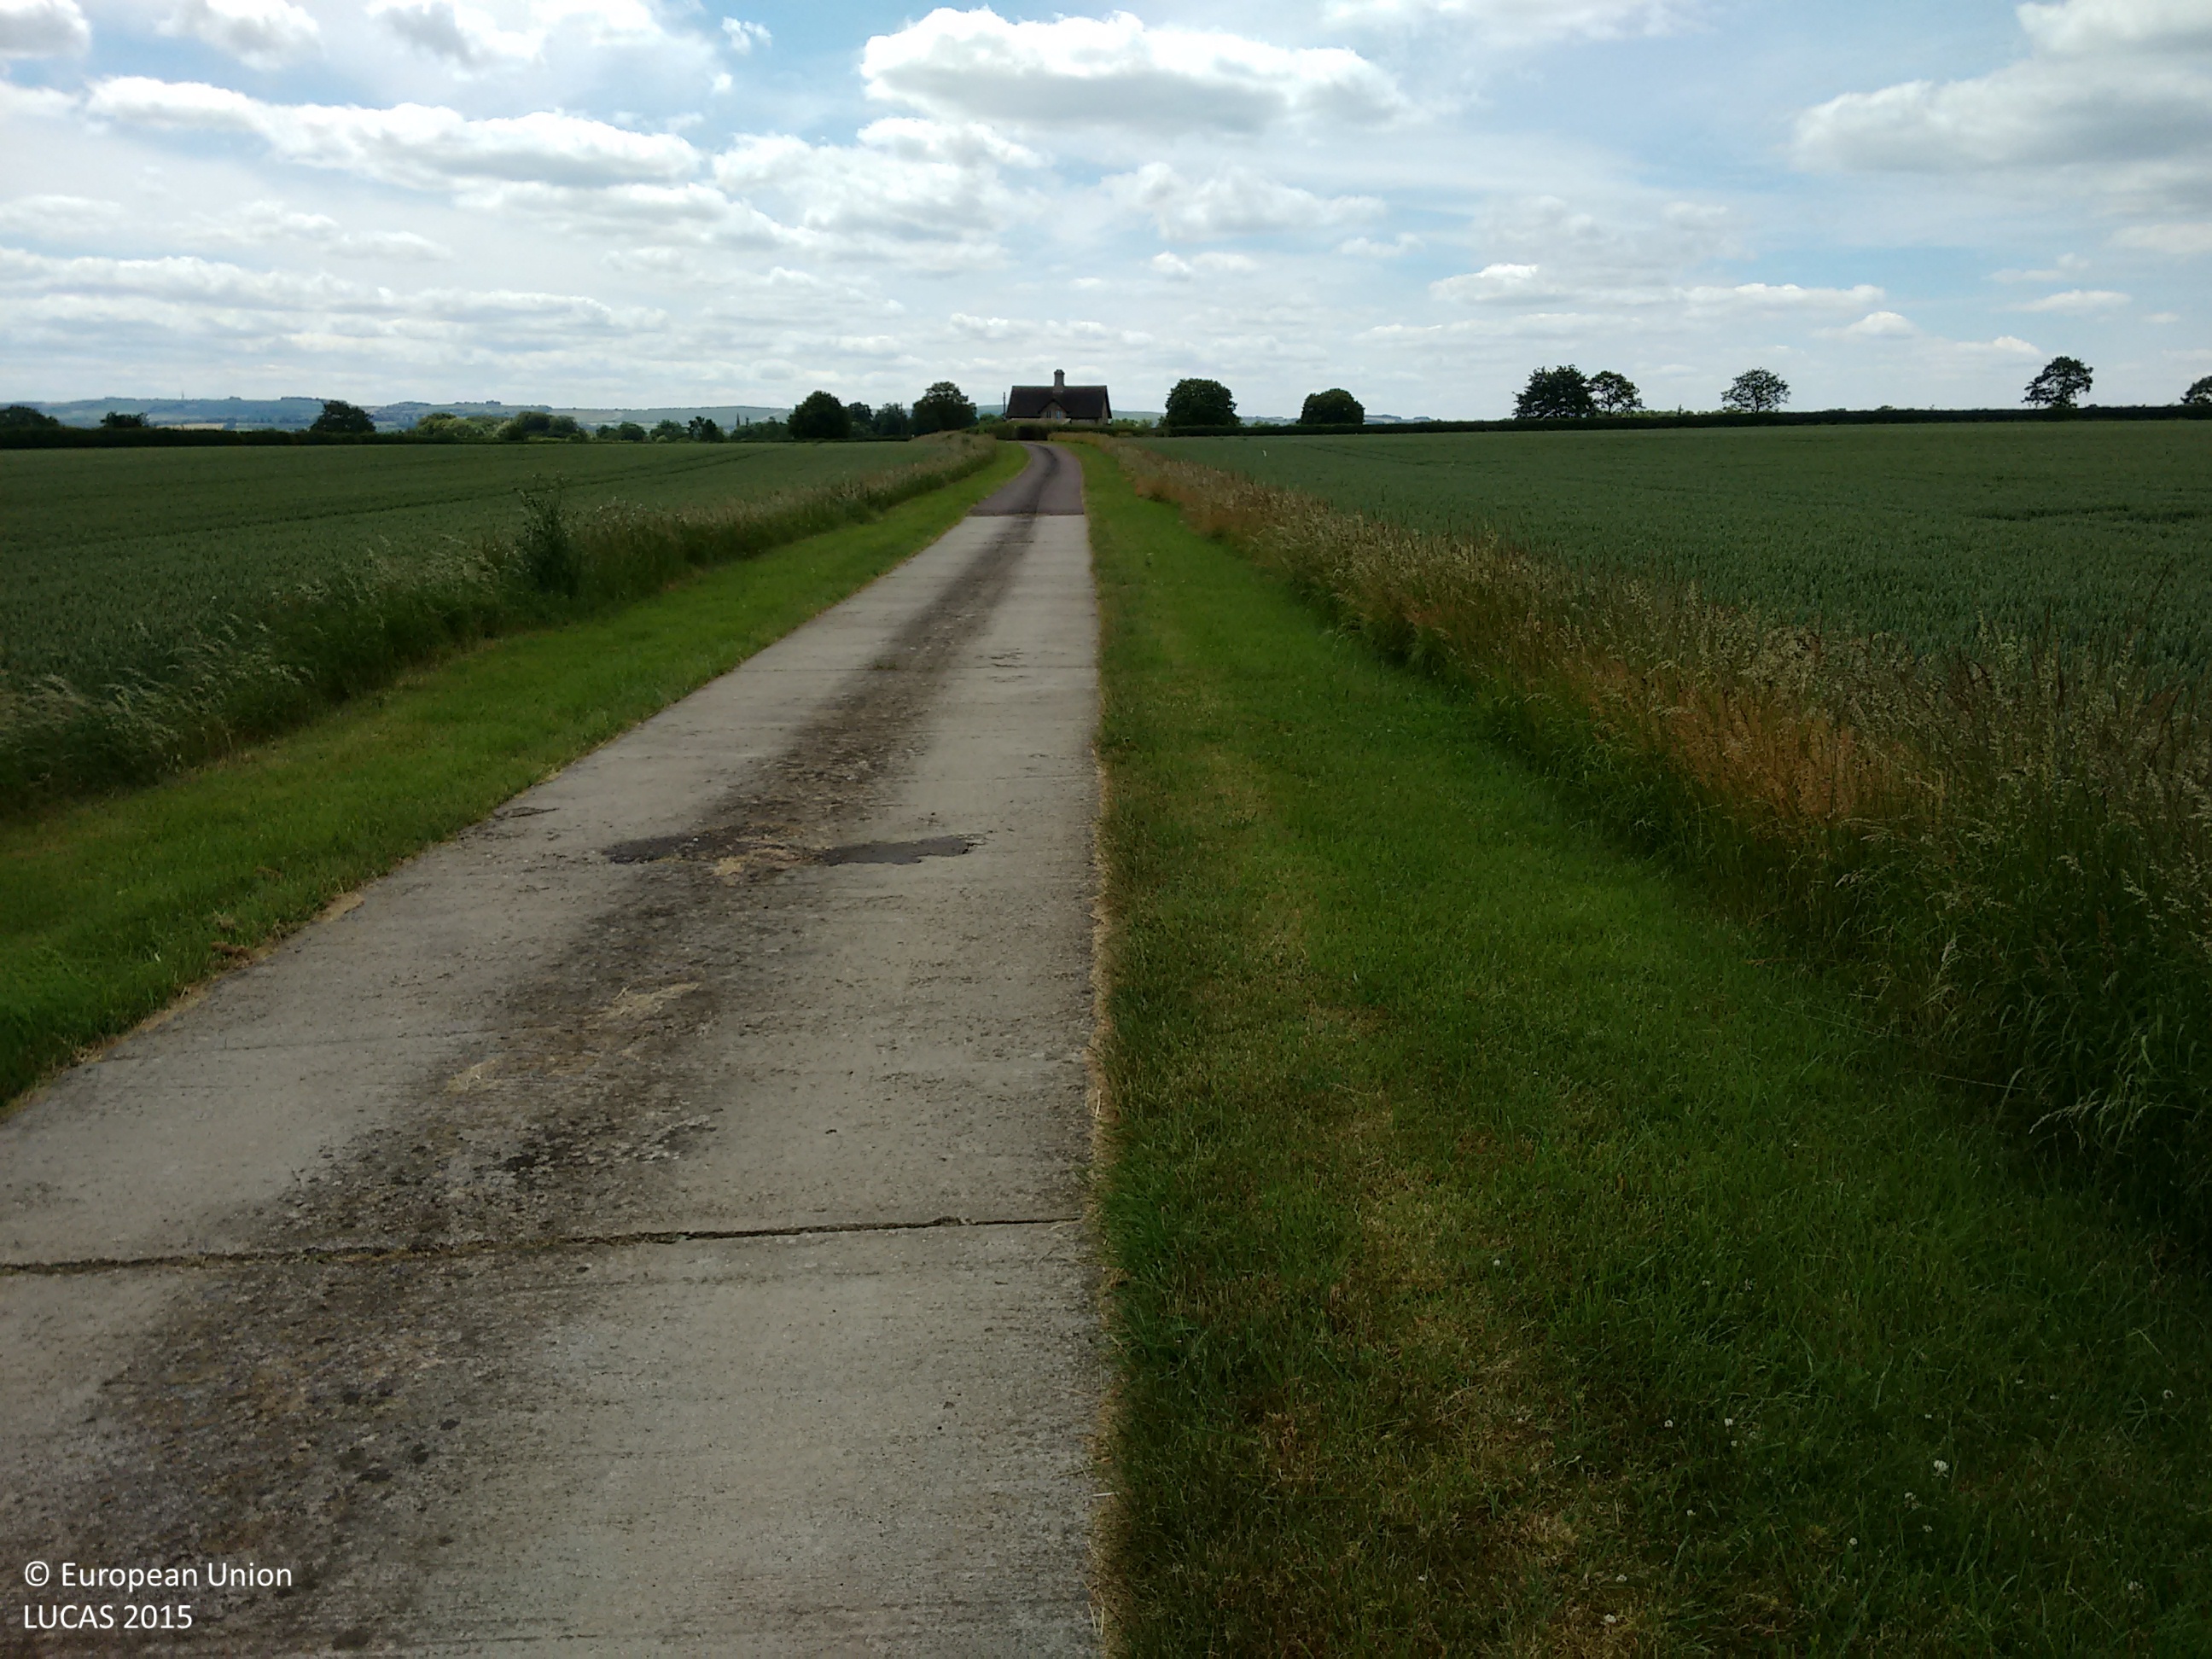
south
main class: Cropland
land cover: Common wheat
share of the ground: > 75 %
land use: Agriculture (excluding fallow land and kitchen gardens)
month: June
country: GB
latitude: 51.6488
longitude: -1.5417
